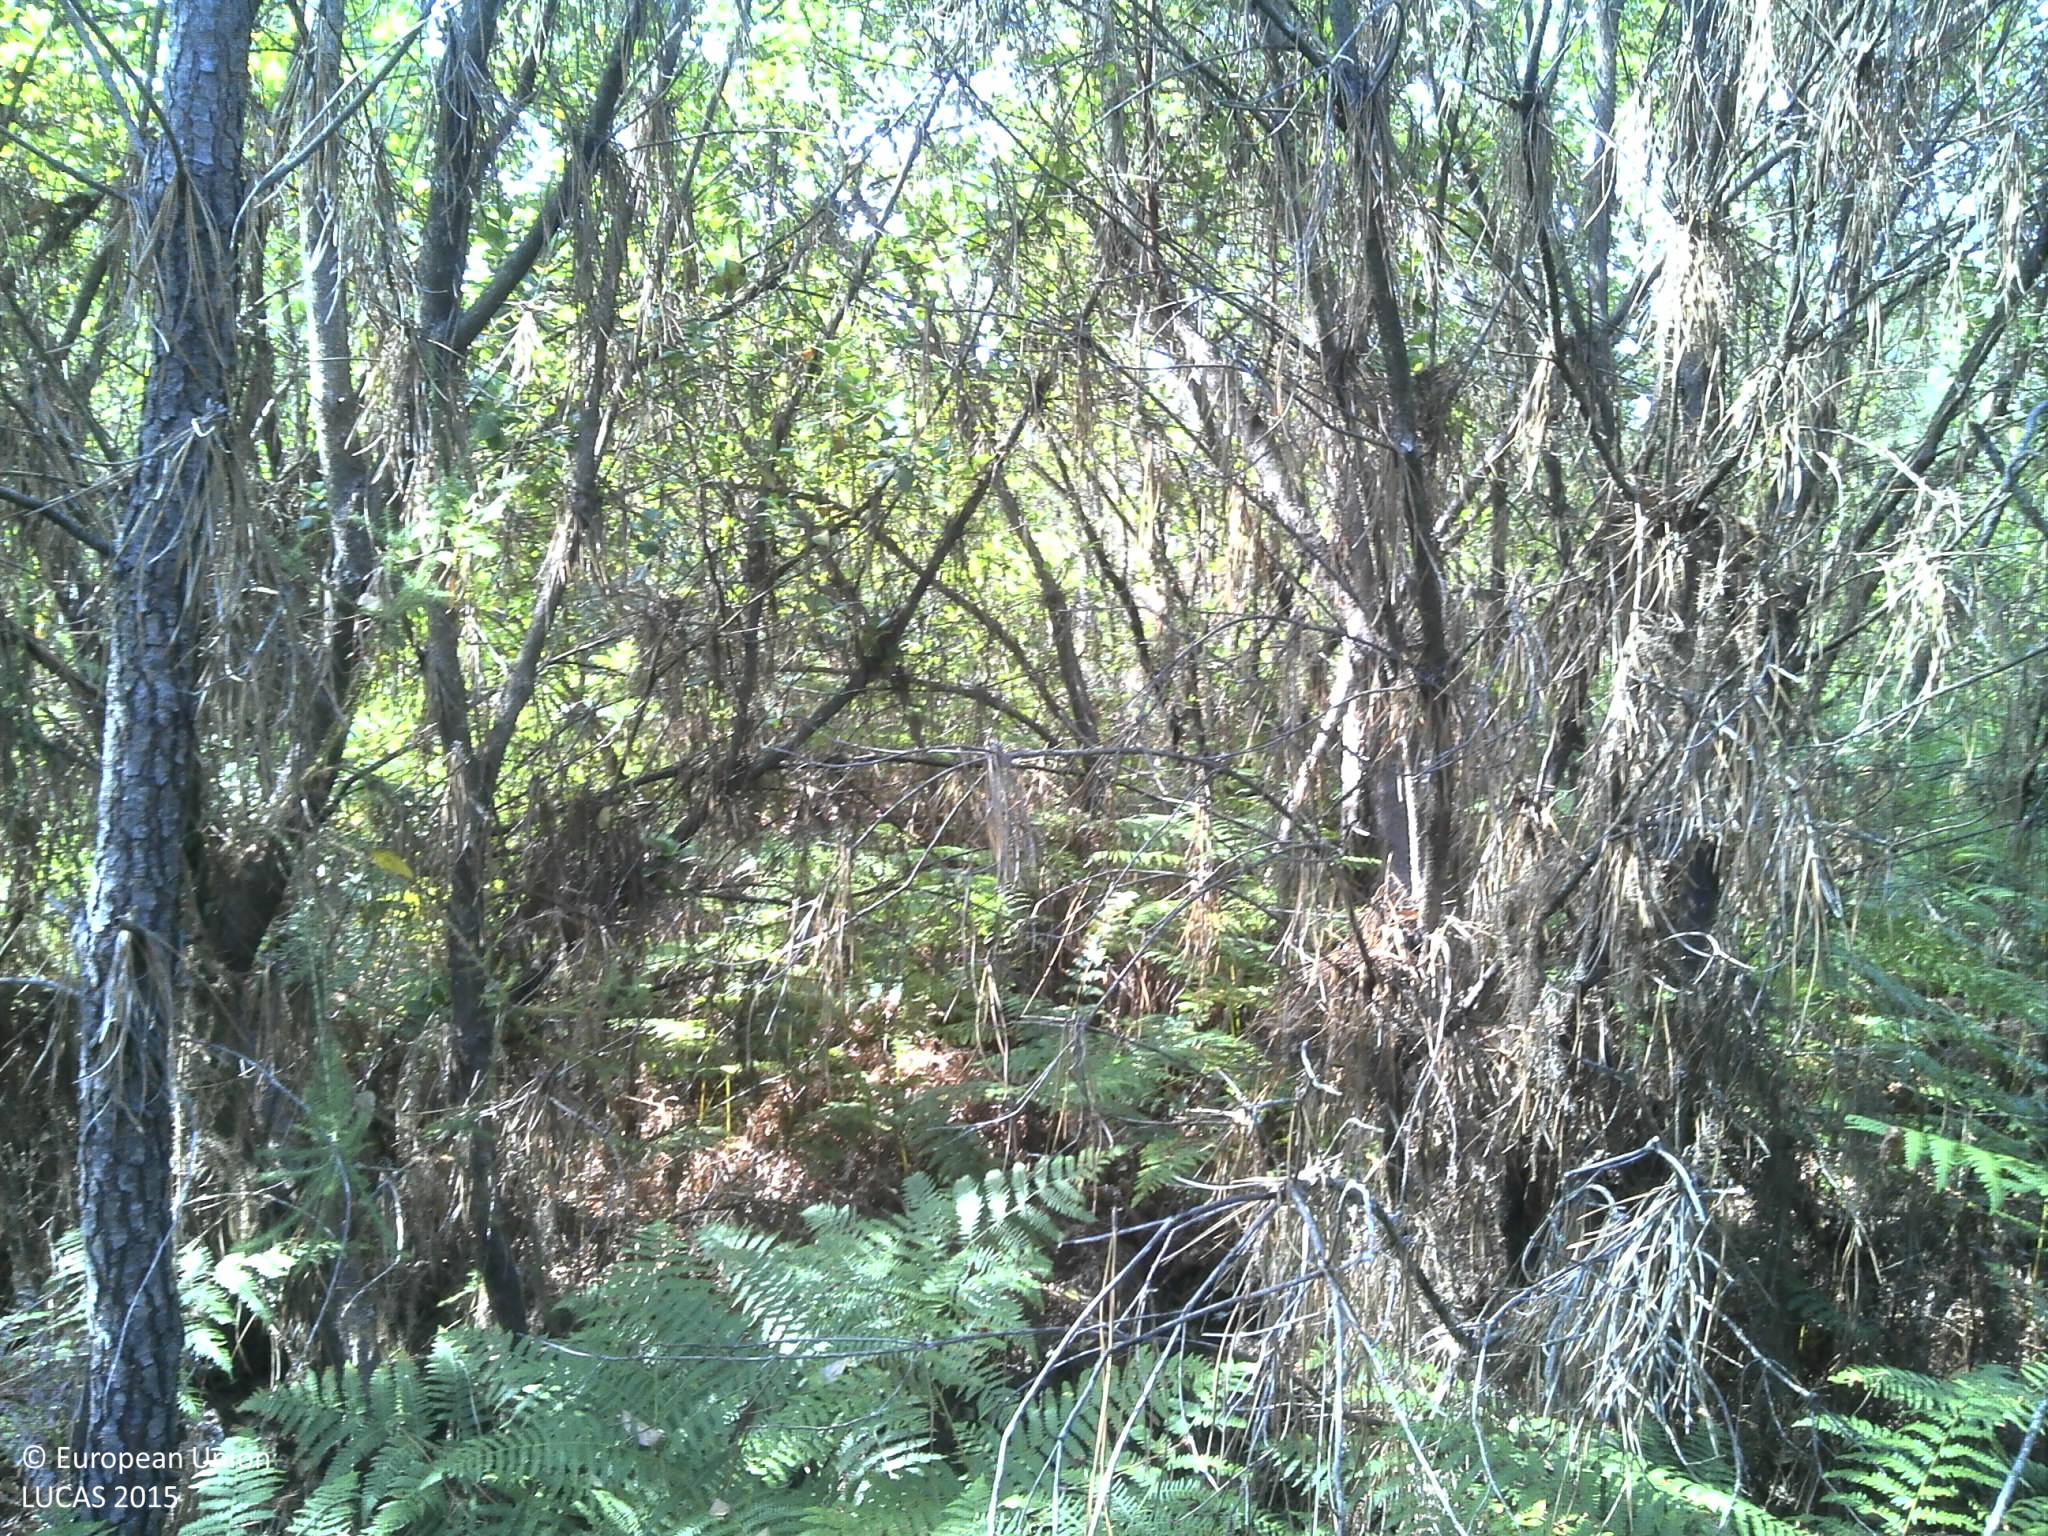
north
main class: Woodland
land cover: Pine dominated coniferous woodland
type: coniferous forest of the mediterranean region
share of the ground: 50 - 75 %
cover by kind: coniferous forest trees 75 %, shrubs 15 %, unconsolidated bare surface 10 %
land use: Forestry
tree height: > 5 m
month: July
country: PT
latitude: 40.2417
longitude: -8.1434
